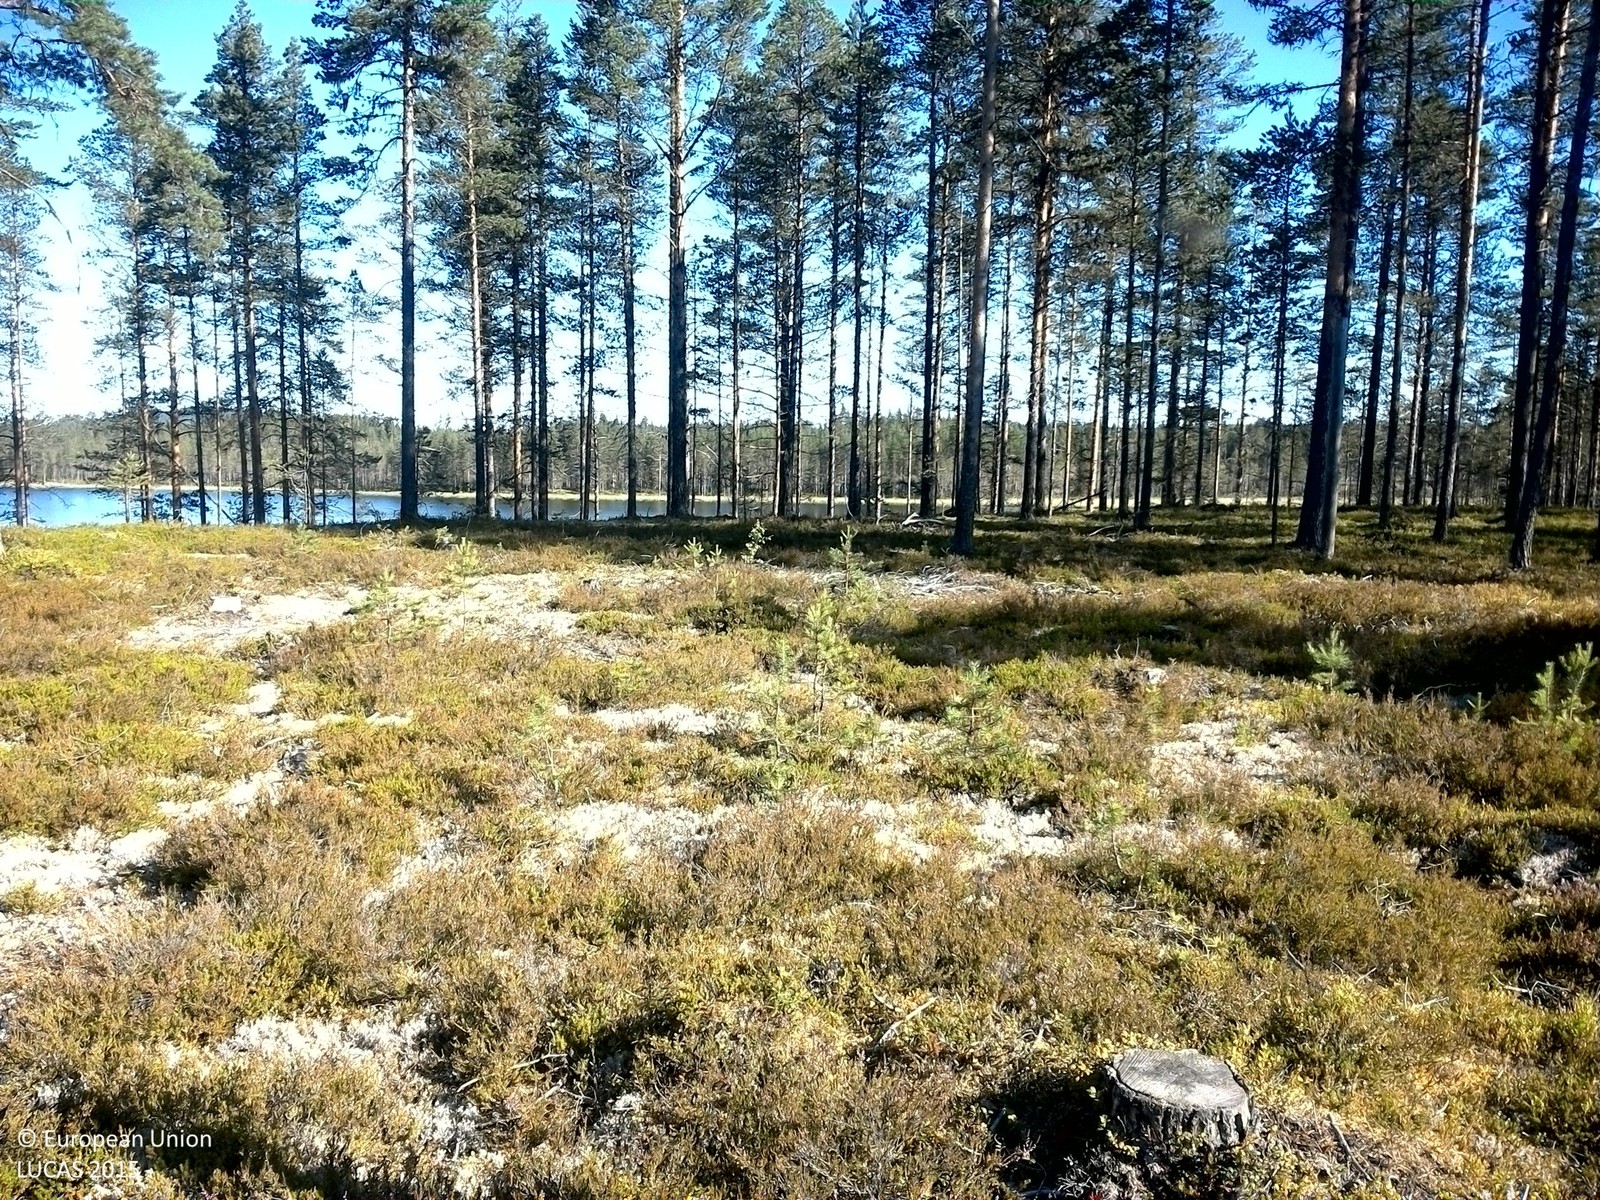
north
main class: Shrubland
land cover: Shrubland with sparse tree cover
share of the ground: 50 - 75 %
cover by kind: shrubs 60 %, lichens and mosses 35 %, coniferous forest trees 5 %
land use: Forestry
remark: Clear cut
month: August
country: SE
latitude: 63.7534
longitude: 16.5997
